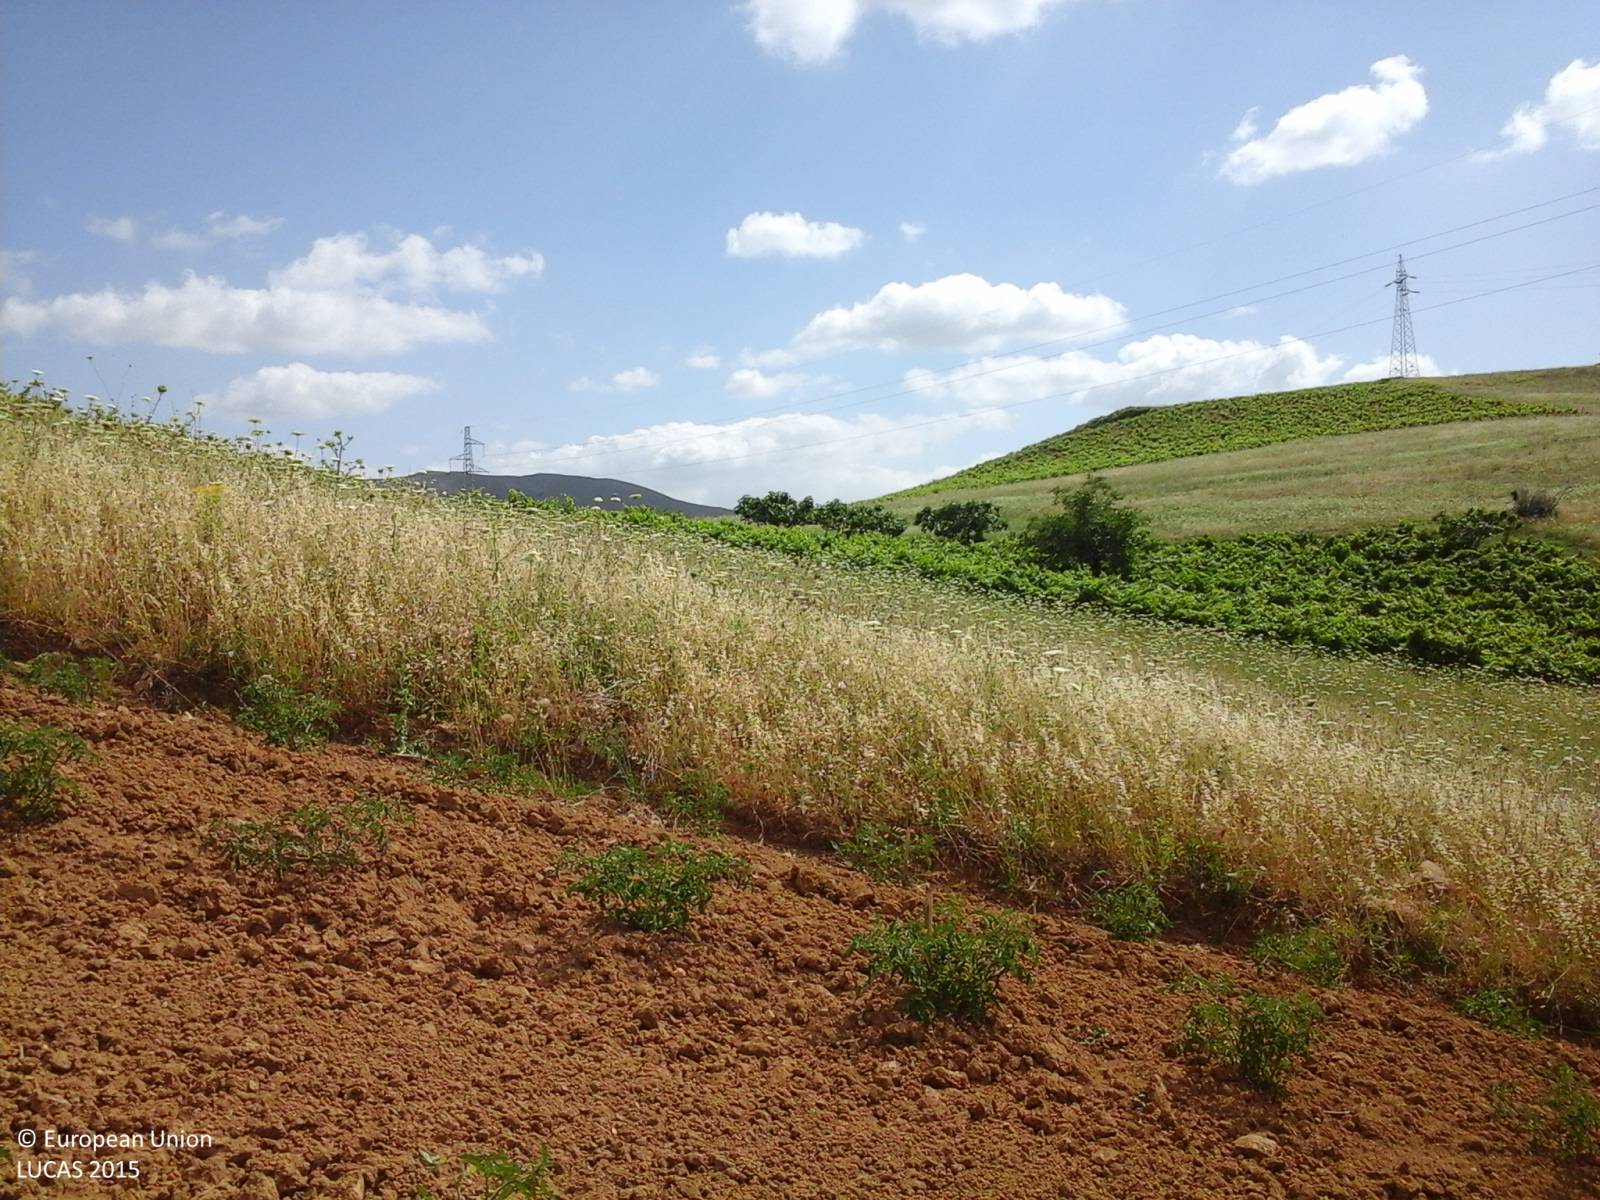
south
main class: Cropland
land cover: Tomatoes
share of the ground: 25 - 50 %
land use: Agriculture (excluding fallow land and kitchen gardens)
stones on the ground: < 10 %
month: June
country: IT
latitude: 38.0229
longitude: 13.1331
